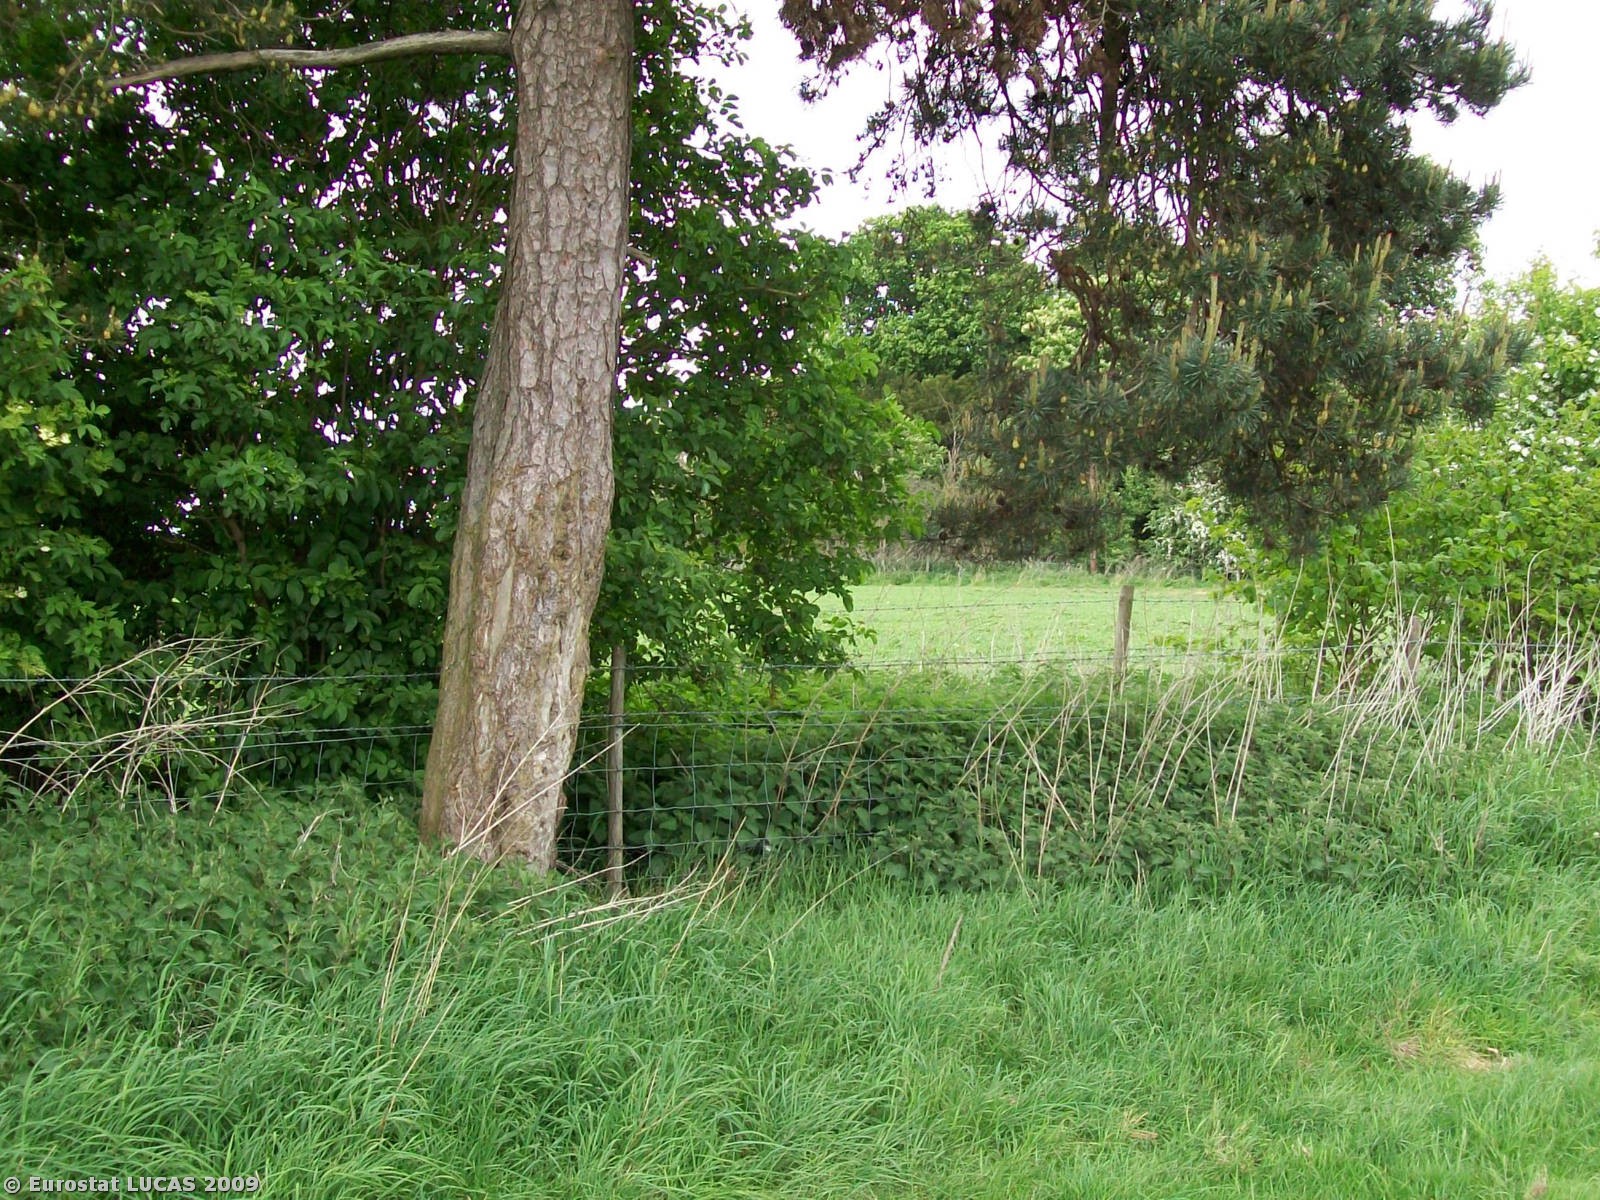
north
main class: Cropland
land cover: Barley
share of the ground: > 75 %
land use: Agriculture (excluding fallow land and kitchen gardens)
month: May
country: GB
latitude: 51.4868
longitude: -0.7706
